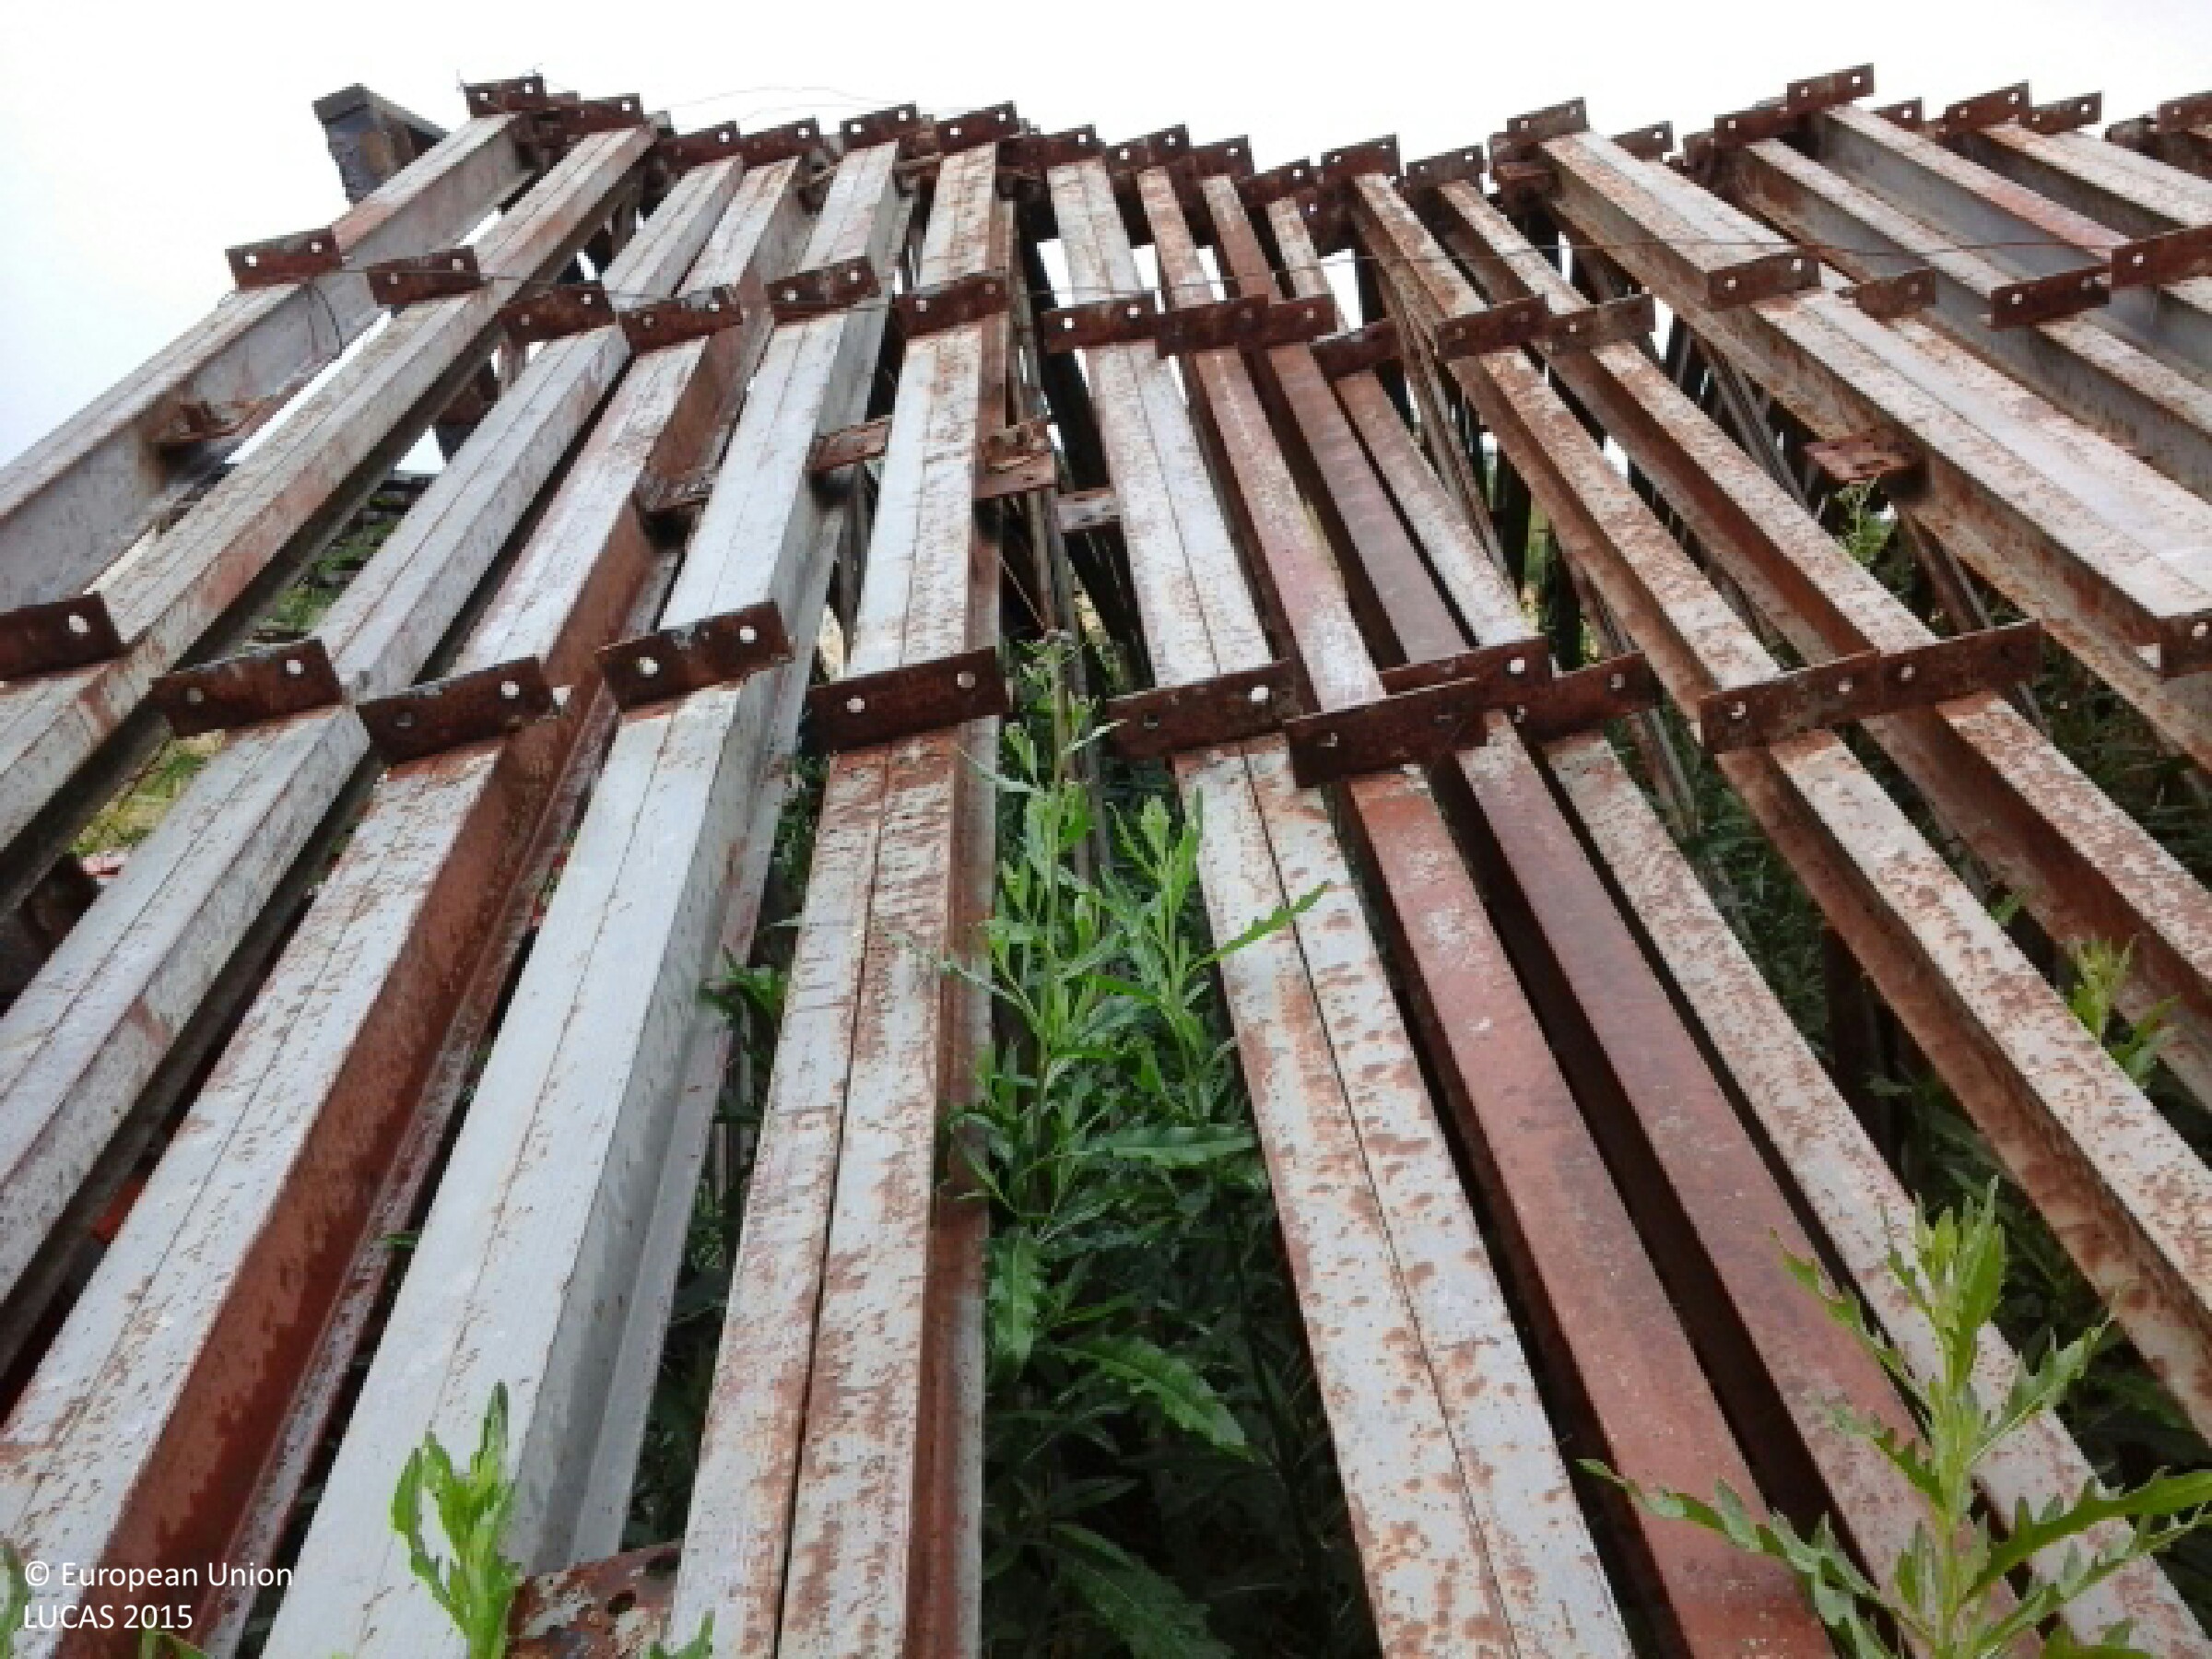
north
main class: Grassland
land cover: Spontaneously vegetated surfaces
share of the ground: > 75 %
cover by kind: herbaceous plants 90 %, unconsolidated bare surface 10 %
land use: Abandoned areas
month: June
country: HU
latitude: 47.9753
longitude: 21.7432
